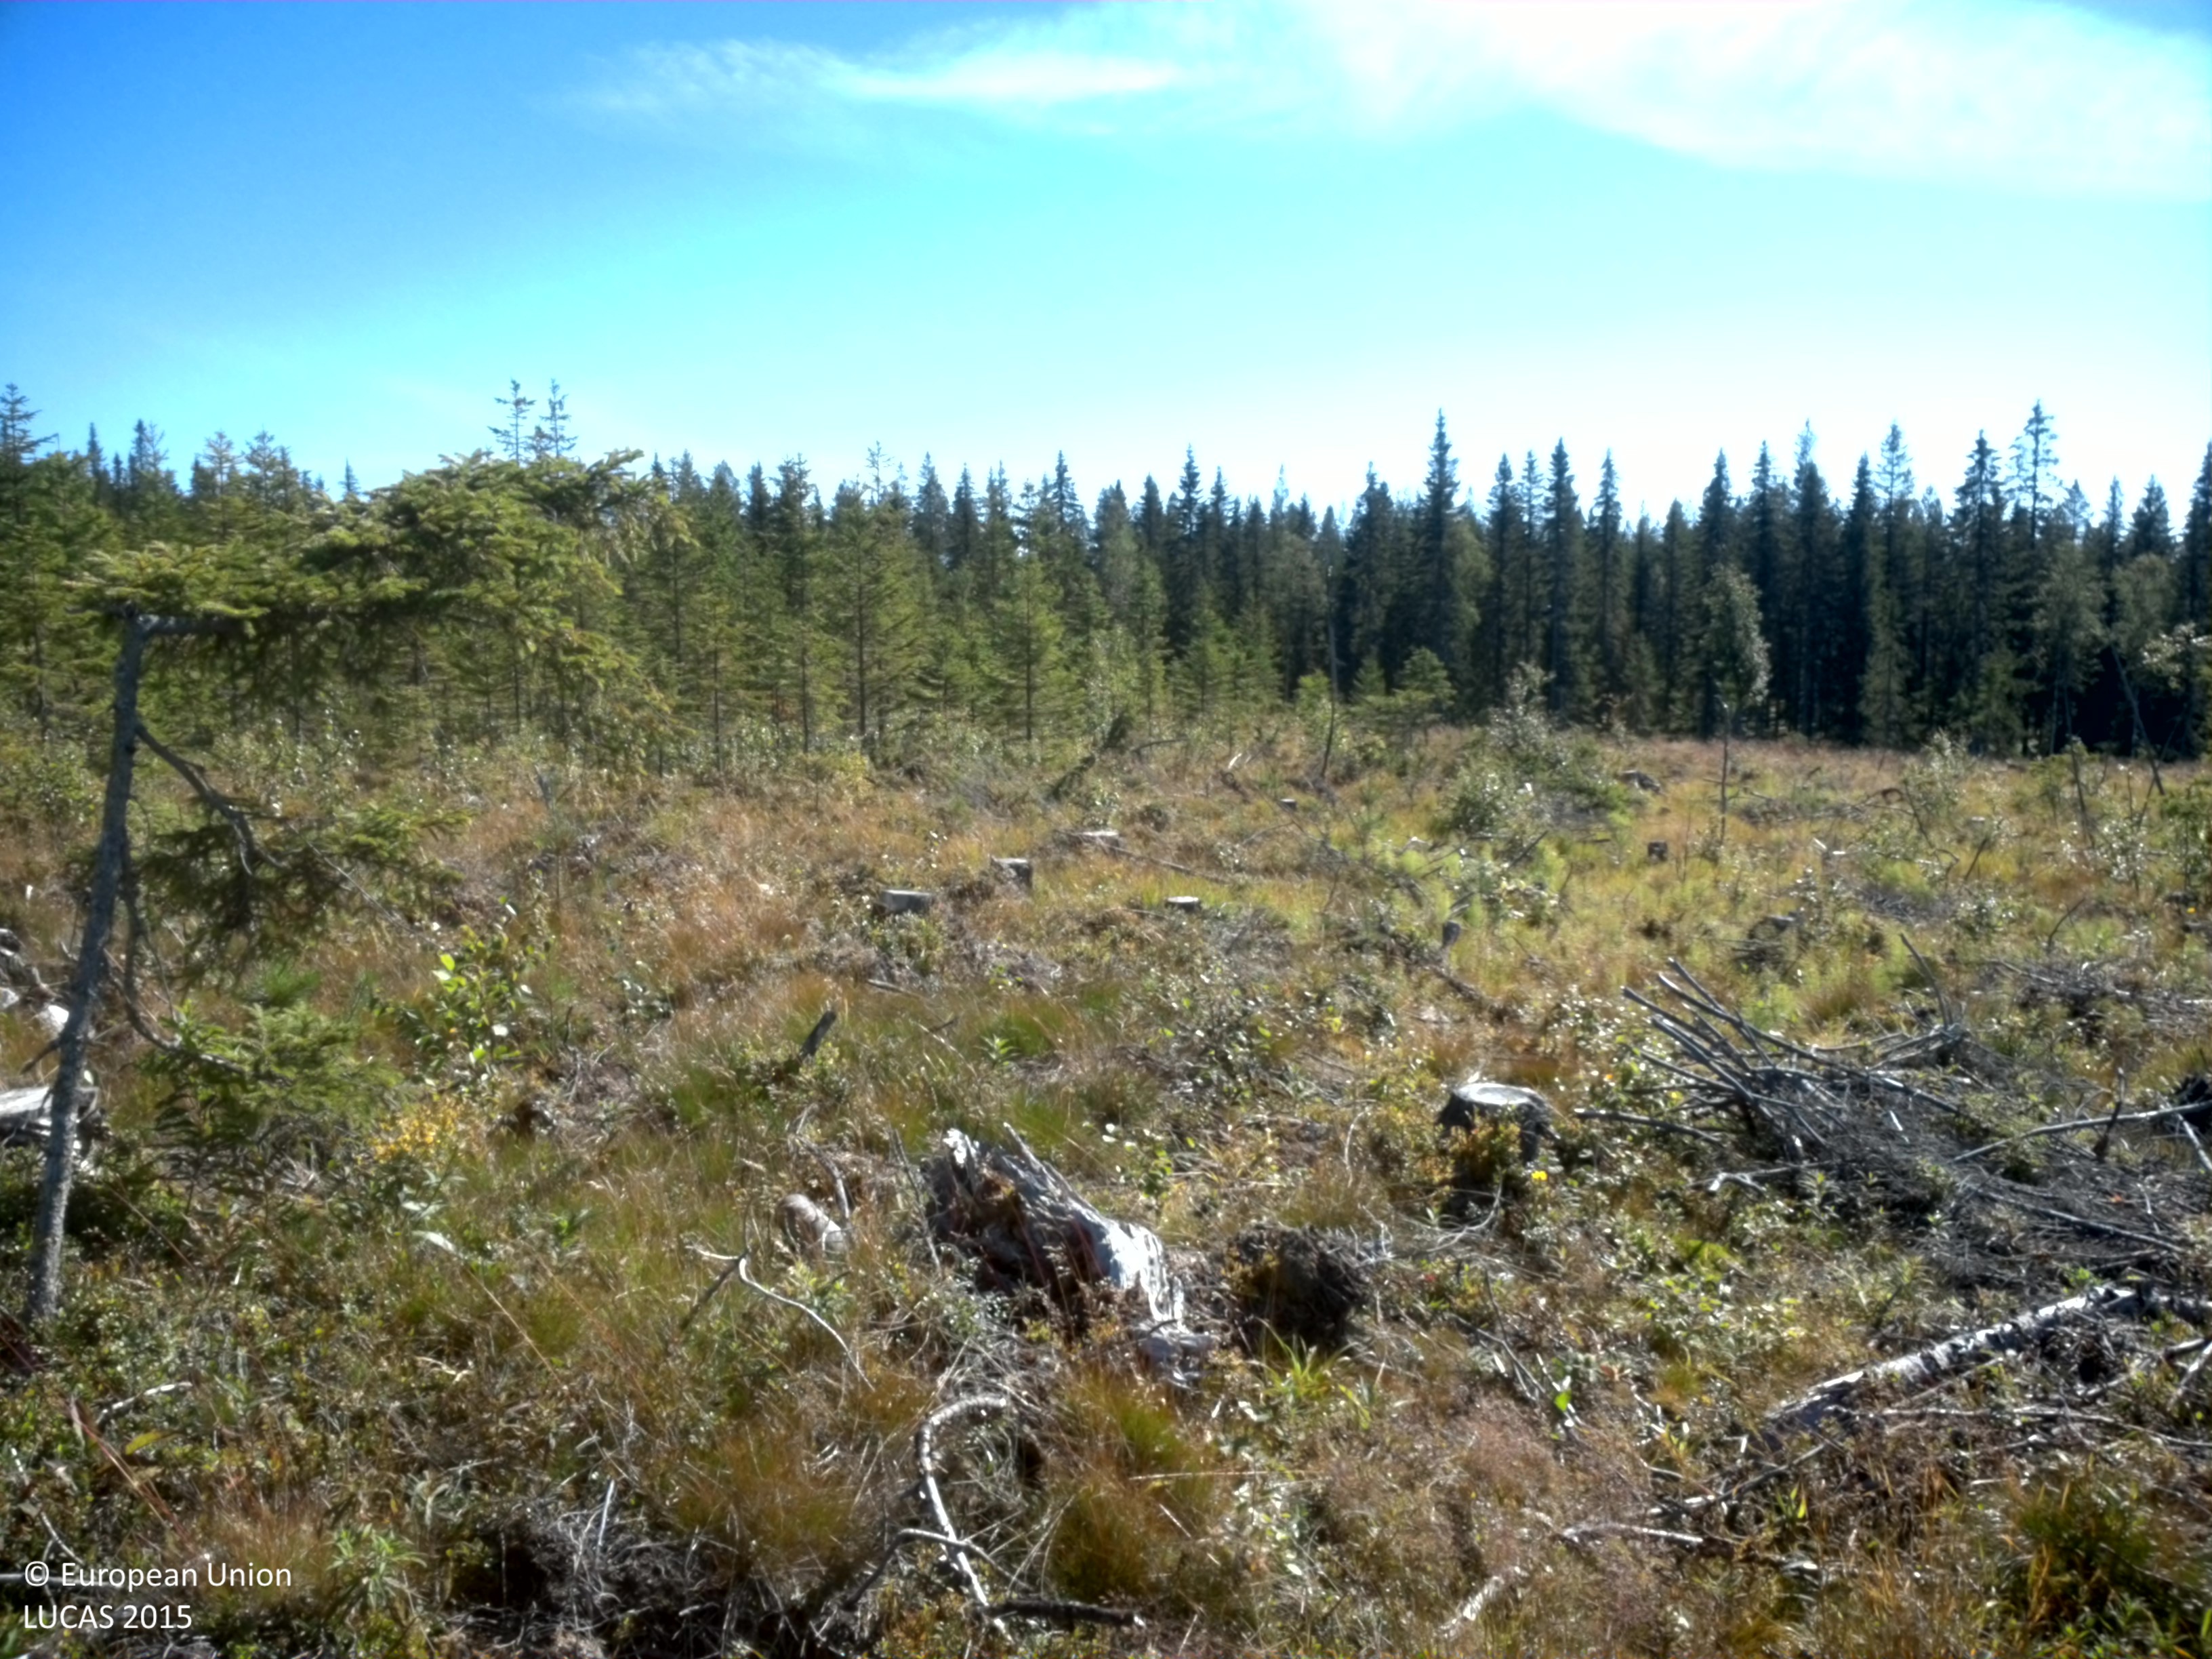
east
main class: Grassland
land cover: Grassland with sparse tree/shrub cover
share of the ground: > 75 %
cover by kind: herbaceous plants 85 %, shrubs 10 %, broadleaved forest trees 5 %
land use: Forestry
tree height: < 5 m
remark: Clear cut
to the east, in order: Grassland with sparse tree/shrub cover; Spruce dominated mixed woodland; Tracks; Spruce dominated coniferous woodland; Ditches and canals; Spruce dominated coniferous woodland; Tracks; Spruce dominated coniferous woodland
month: August
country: SE
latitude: 64.3039
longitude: 18.7141
